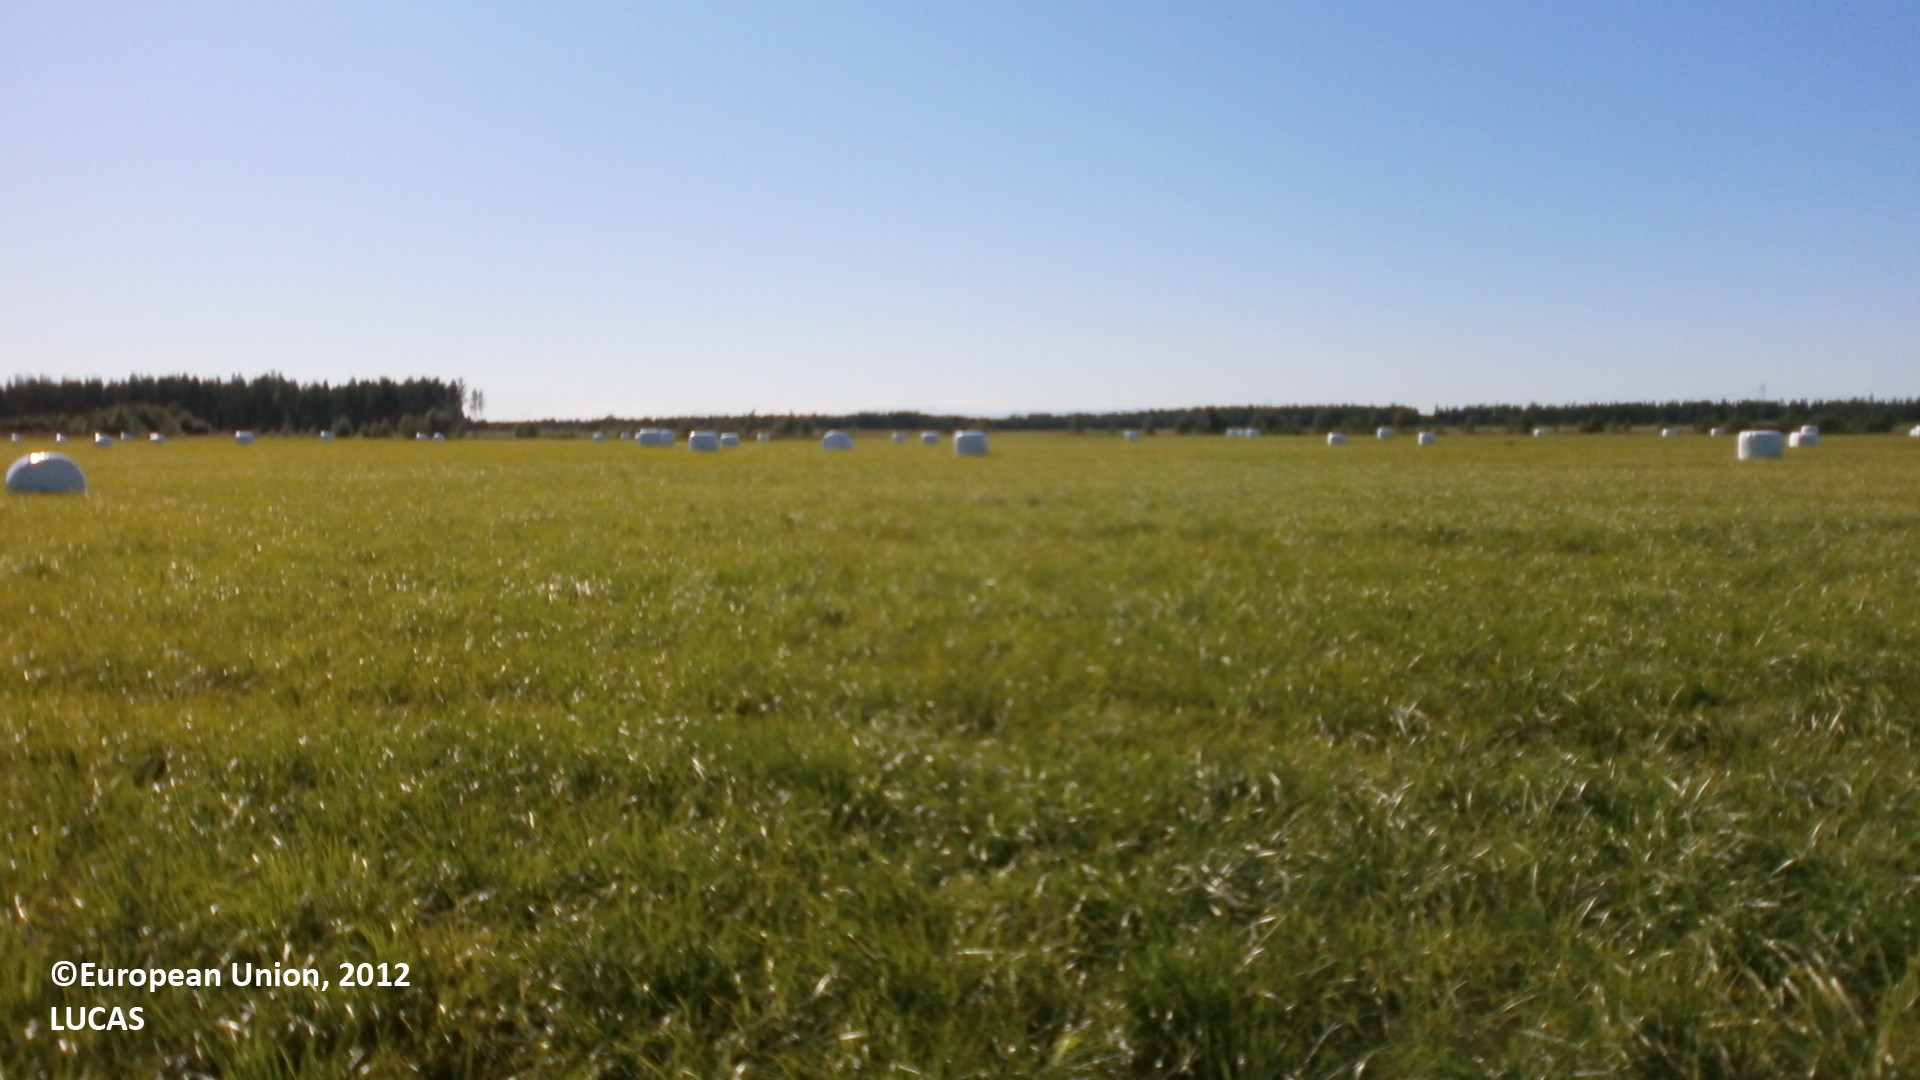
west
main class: Cropland
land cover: Temporary grasslands
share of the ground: > 75 %
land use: Agriculture (excluding fallow land and kitchen gardens)
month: July
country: FI
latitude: 64.1649
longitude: 23.9455
